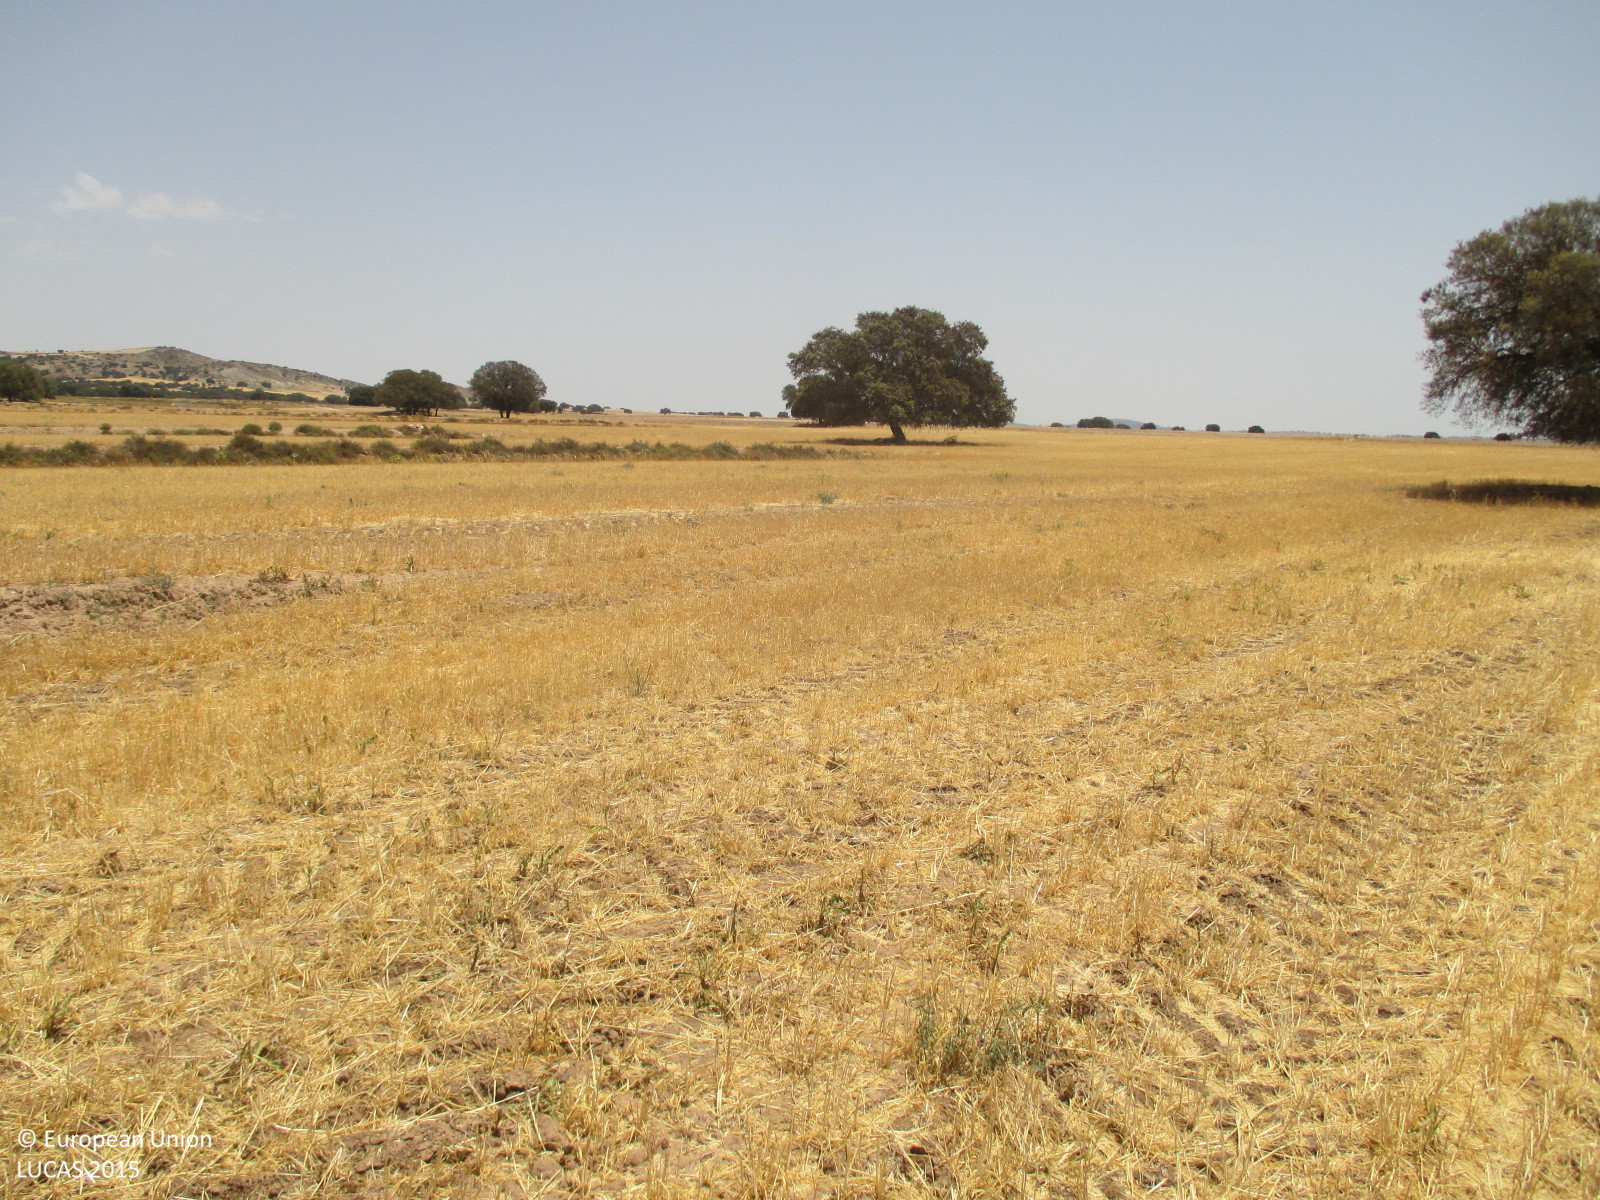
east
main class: Cropland
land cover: Barley
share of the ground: < 10 %
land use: Agriculture (excluding fallow land and kitchen gardens)
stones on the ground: < 10 %
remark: Harvested field
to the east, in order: Barley; Grass margins; Barley; Broadleaved woodland; Barley; Single bushes/trees; Tracks; Other bare soil
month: July
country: ES
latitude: 37.8469
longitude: -2.2734
